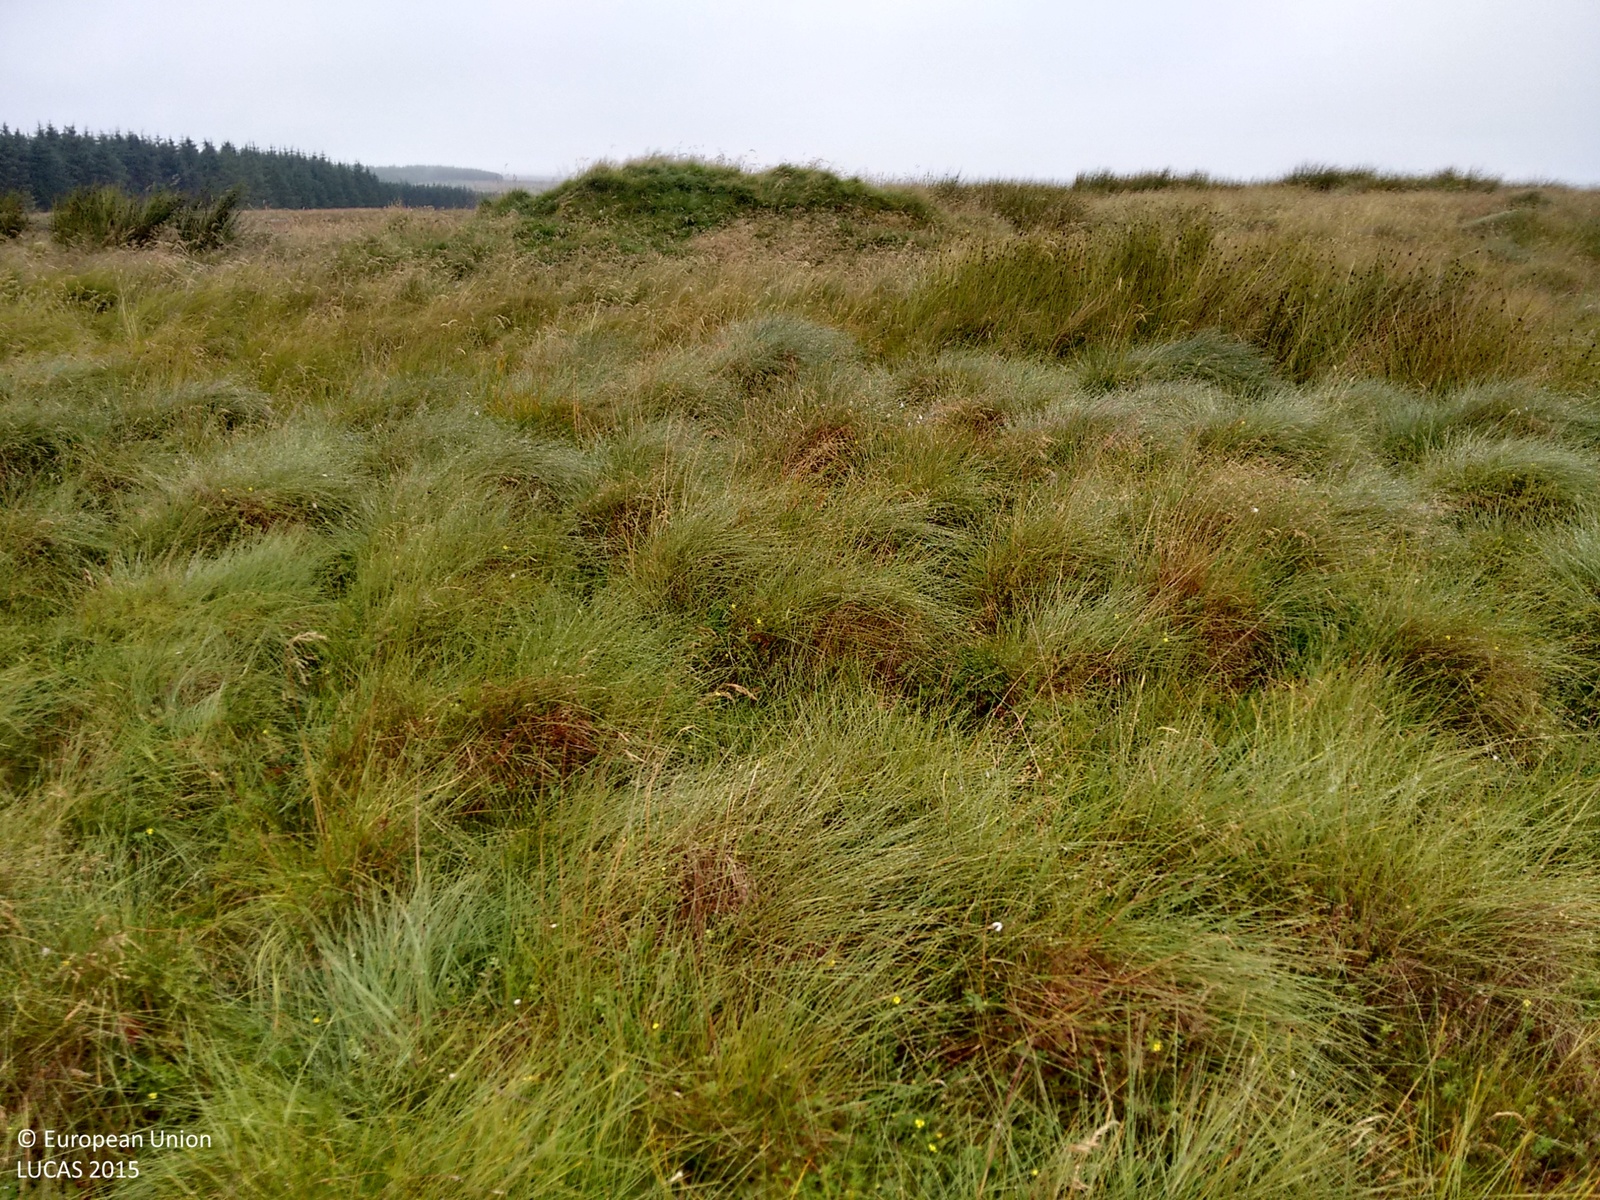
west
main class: Grassland
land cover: Grassland without tree/shrub cover
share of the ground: > 75 %
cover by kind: herbaceous plants 100 %
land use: Energy production
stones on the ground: < 10 %
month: August
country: GB
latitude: 58.4141
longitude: -3.2931
